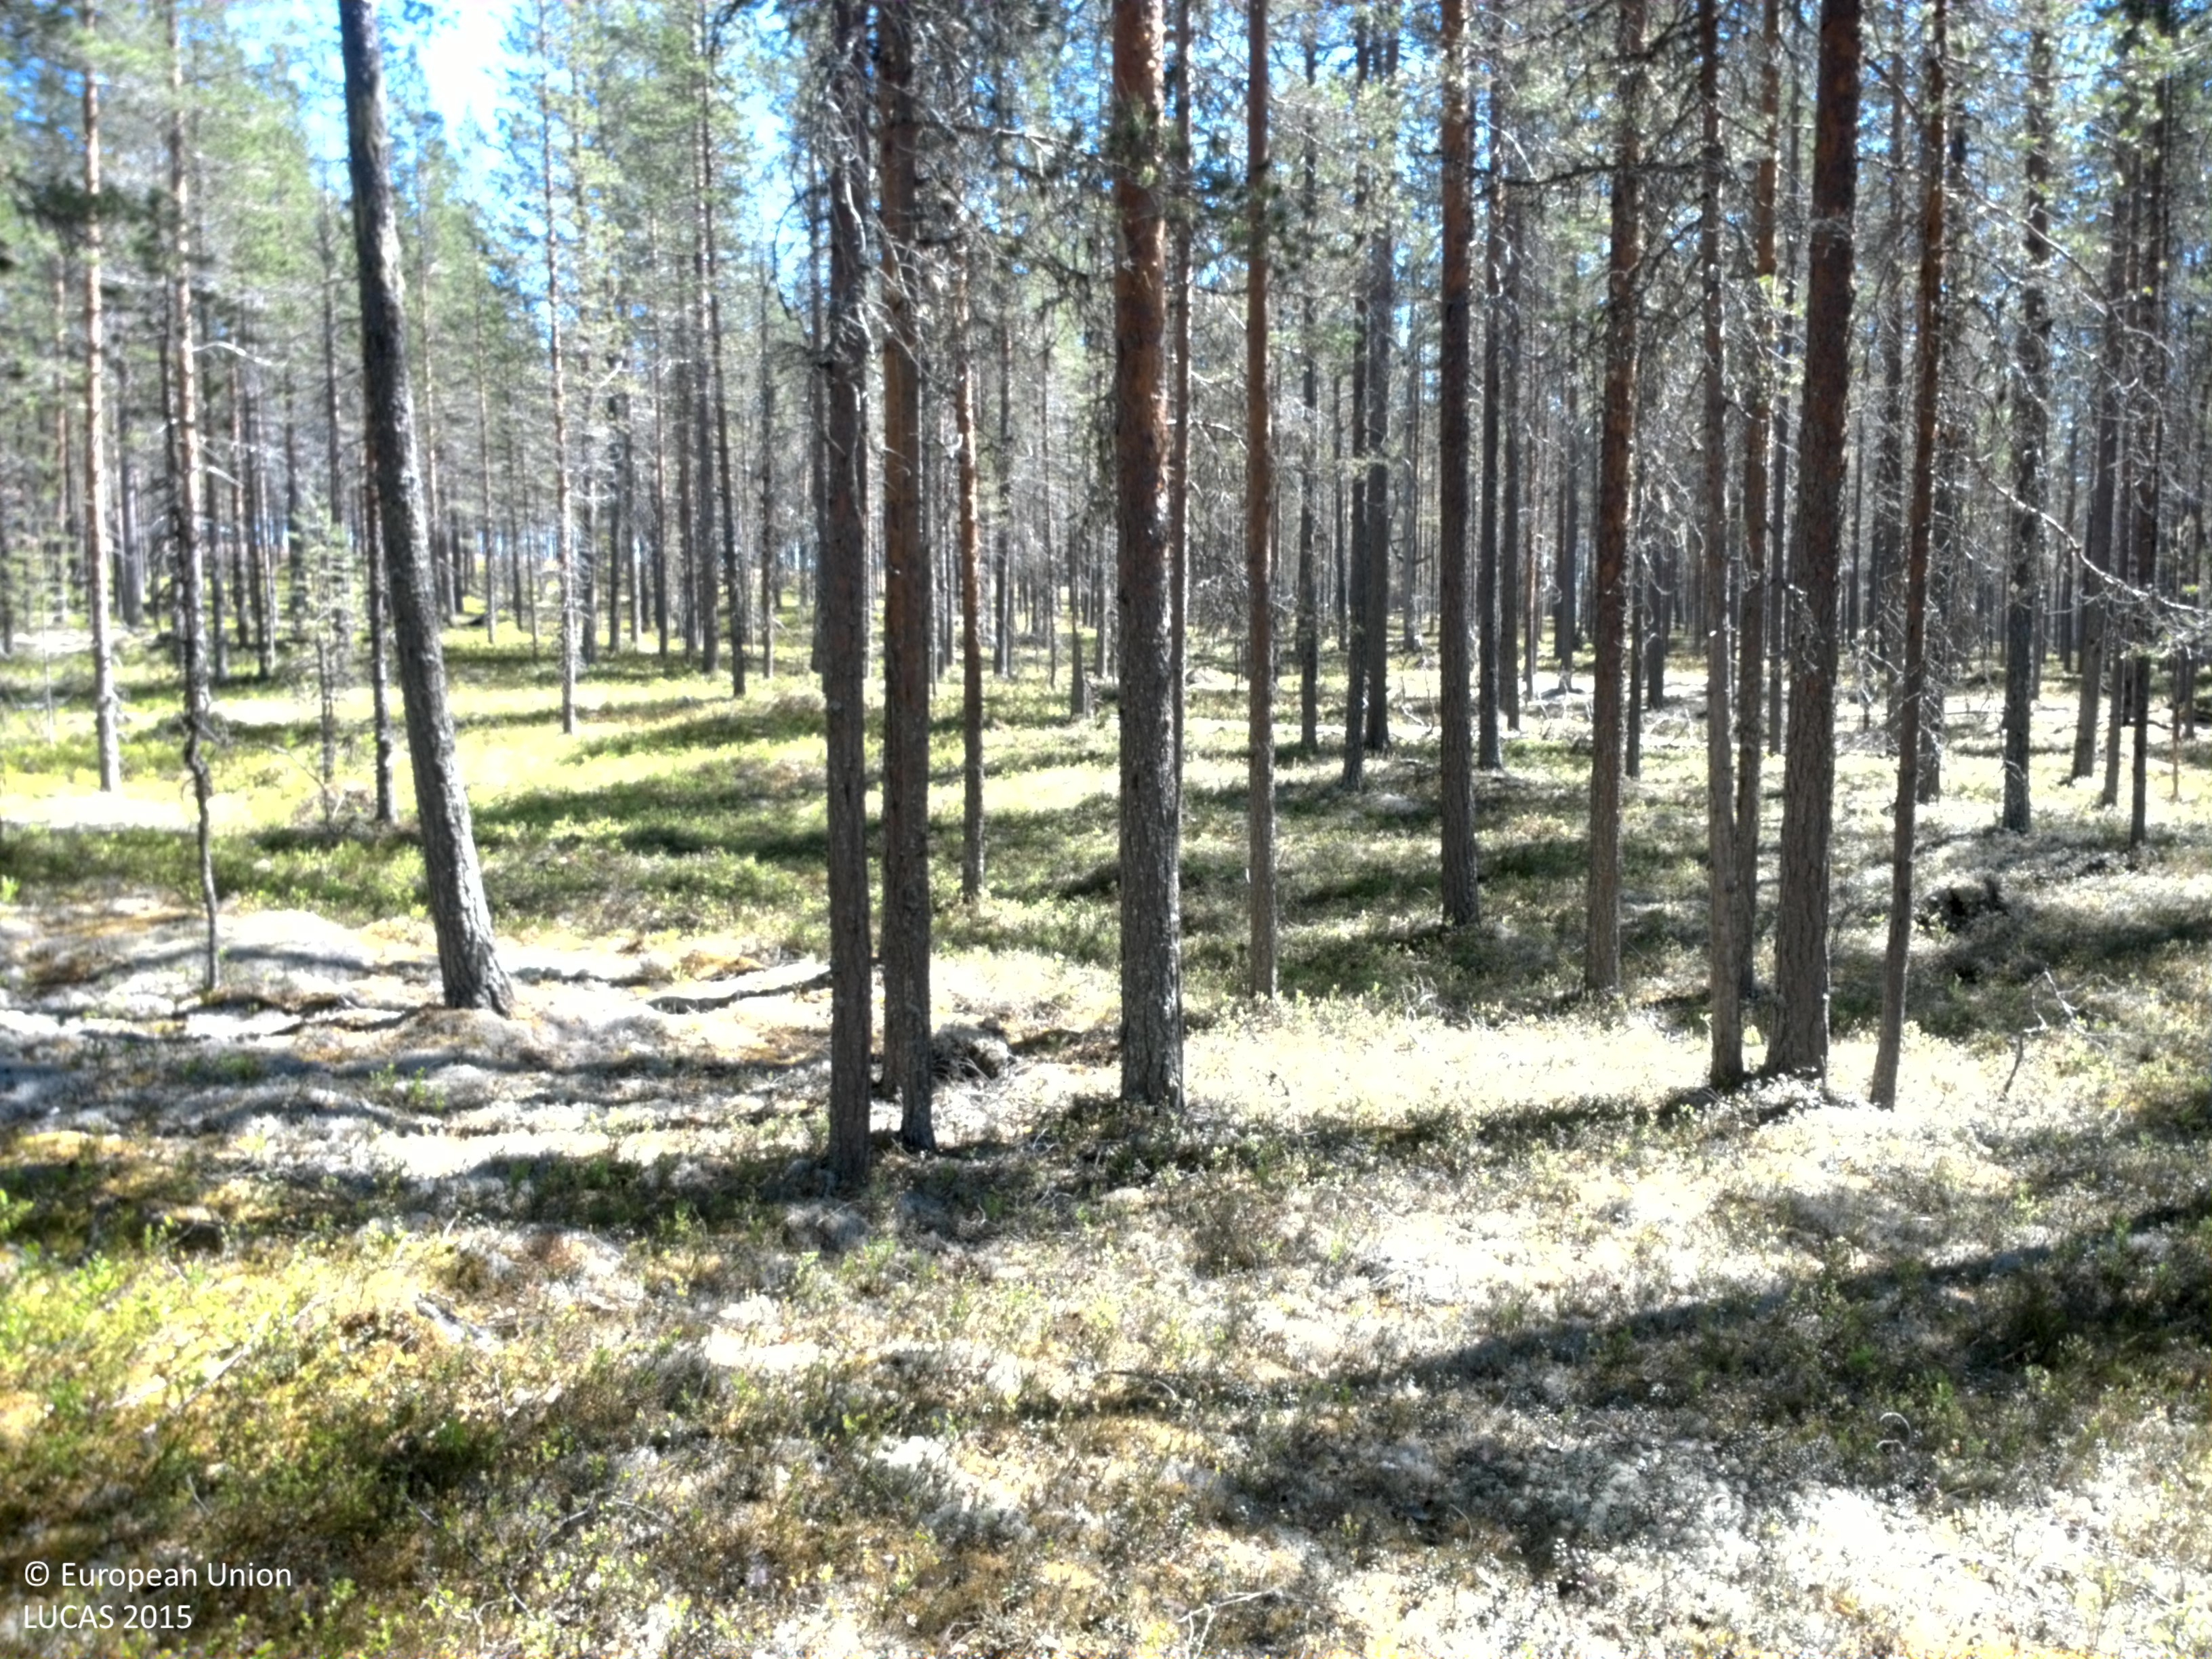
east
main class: Woodland
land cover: Pine dominated coniferous woodland
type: boreal forest
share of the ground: > 75 %
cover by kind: coniferous forest trees 75 %, herbaceous plants 15 %, lichens and mosses 10 %
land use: Forestry
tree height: > 5 m
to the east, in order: Pine dominated coniferous woodland; Paved roads, cycling and walking lanes; Pine dominated coniferous woodland
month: June
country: SE
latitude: 61.3957
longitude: 13.6384
